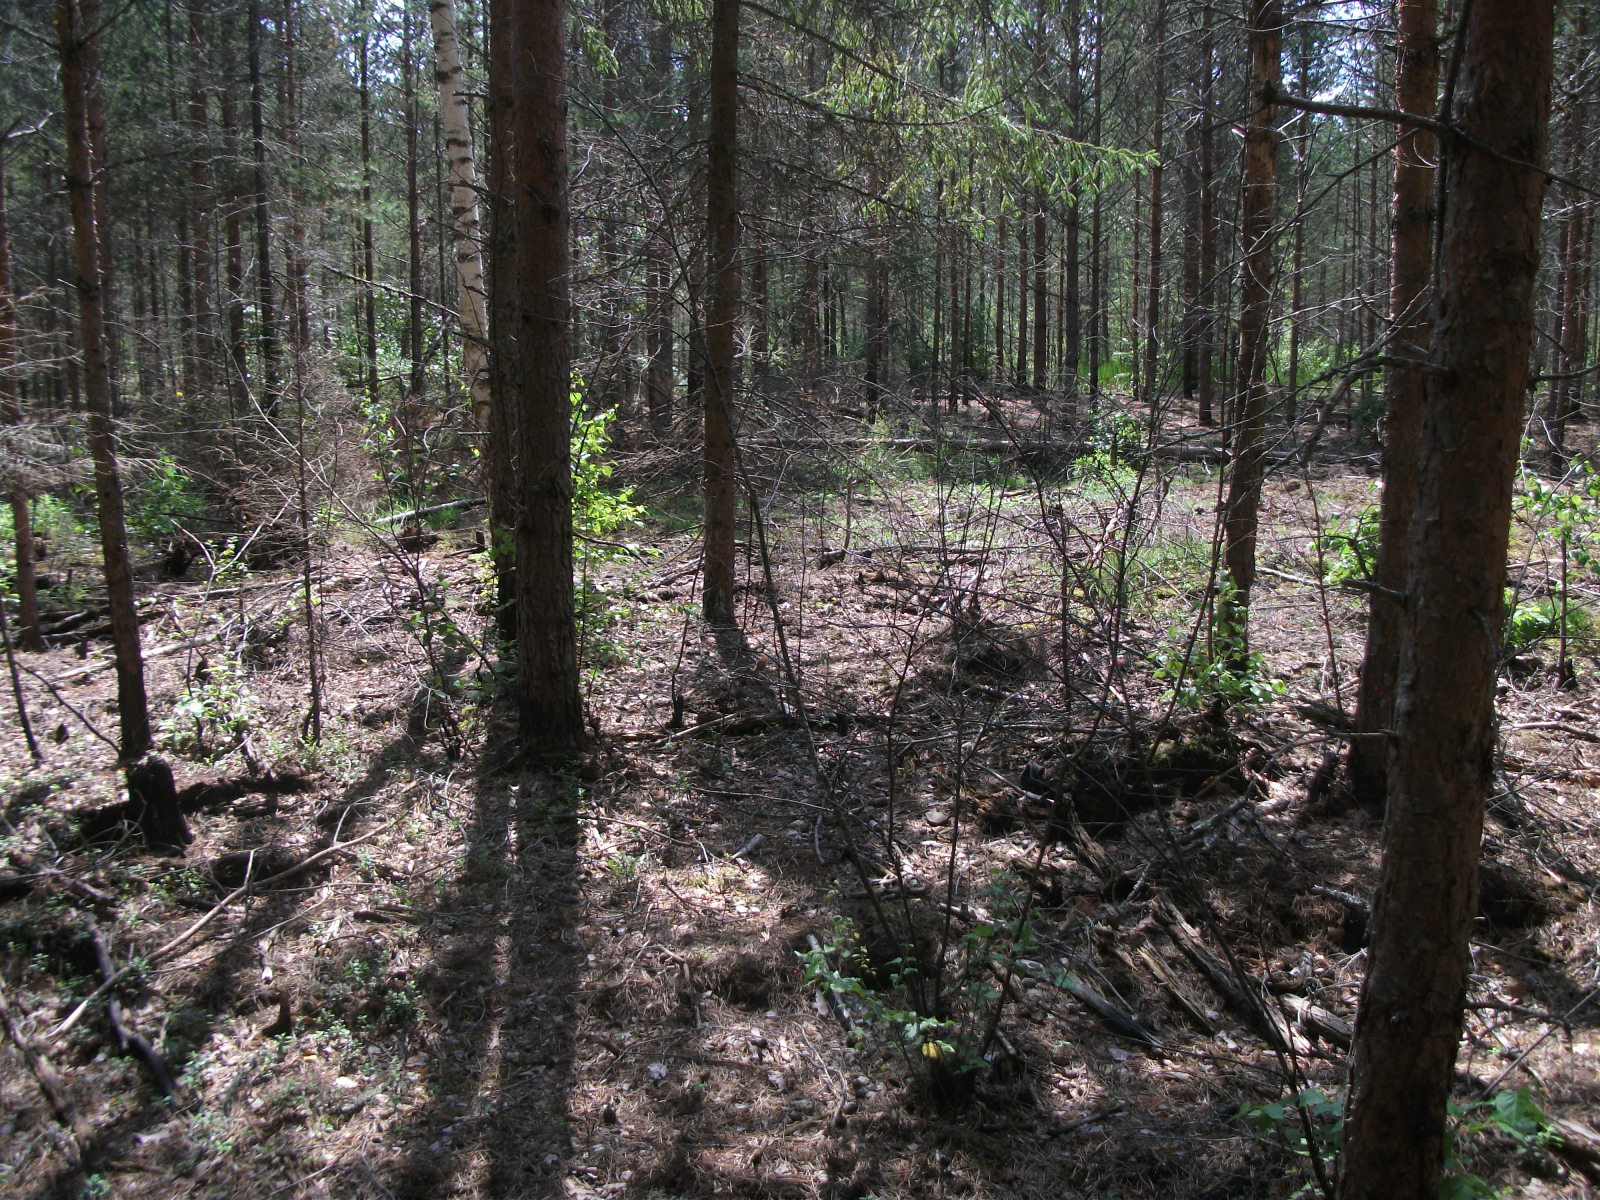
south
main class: Woodland
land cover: Pine dominated coniferous woodland
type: hemiboreal forest and nemoral coniferous forest and mixed broadleaved-coniferous forest
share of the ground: > 75 %
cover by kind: coniferous forest trees 100 %
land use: Forestry
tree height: > 5 m
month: July
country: LV
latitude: 57.0470
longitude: 26.3098
